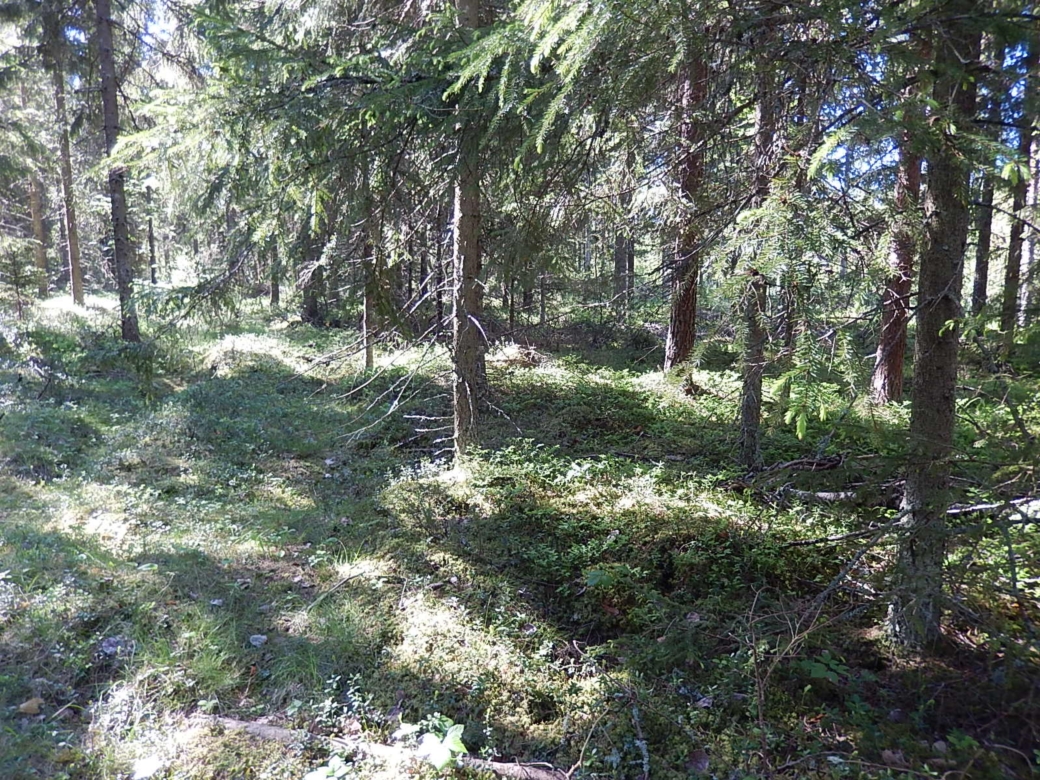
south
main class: Woodland
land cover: Spruce dominated coniferous woodland
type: boreal forest
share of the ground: > 75 %
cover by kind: coniferous forest trees 85 %, shrubs 15 %
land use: Forestry
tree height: > 5 m
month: June
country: FI
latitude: 62.0396
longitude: 21.5374
